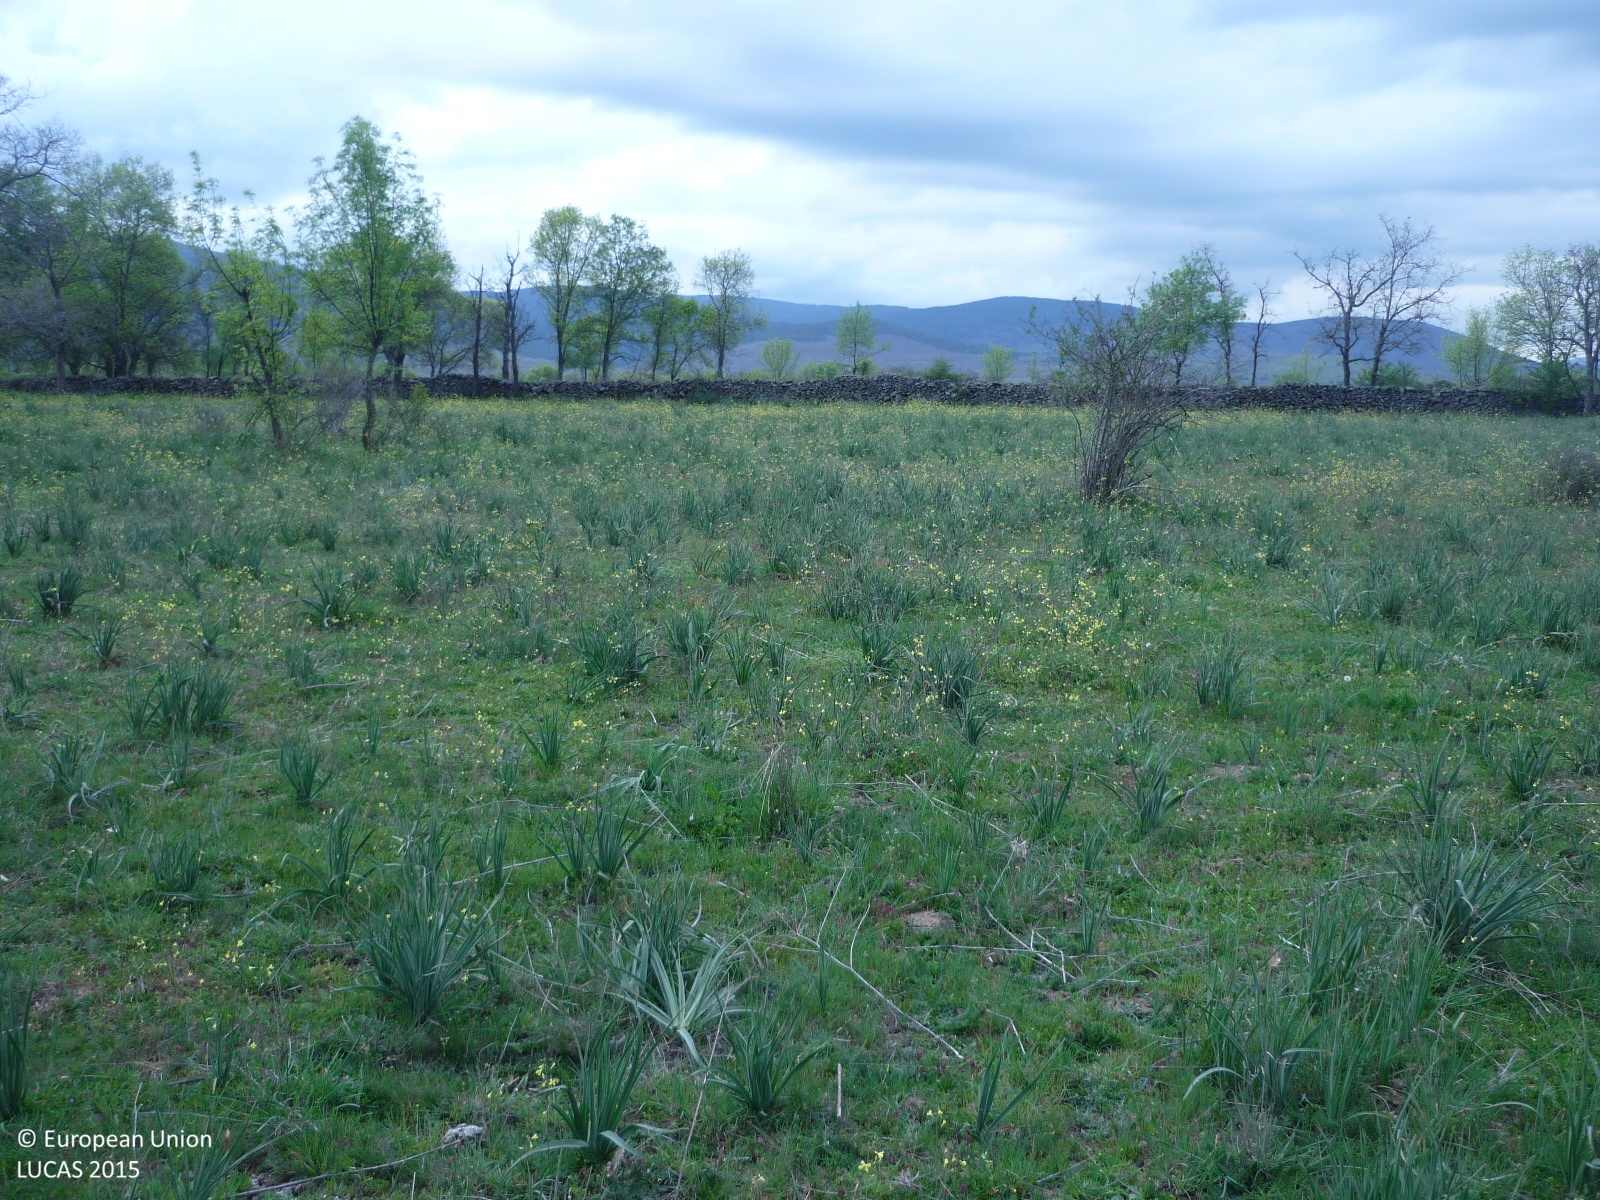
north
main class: Grassland
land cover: Grassland with sparse tree/shrub cover
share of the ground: > 75 %
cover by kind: herbaceous plants 85 %, shrubs 10 %, broadleaved forest trees 5 %
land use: Agriculture (excluding fallow land and kitchen gardens)
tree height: < 5 m
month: April
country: ES
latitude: 40.9892
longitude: -3.6783
